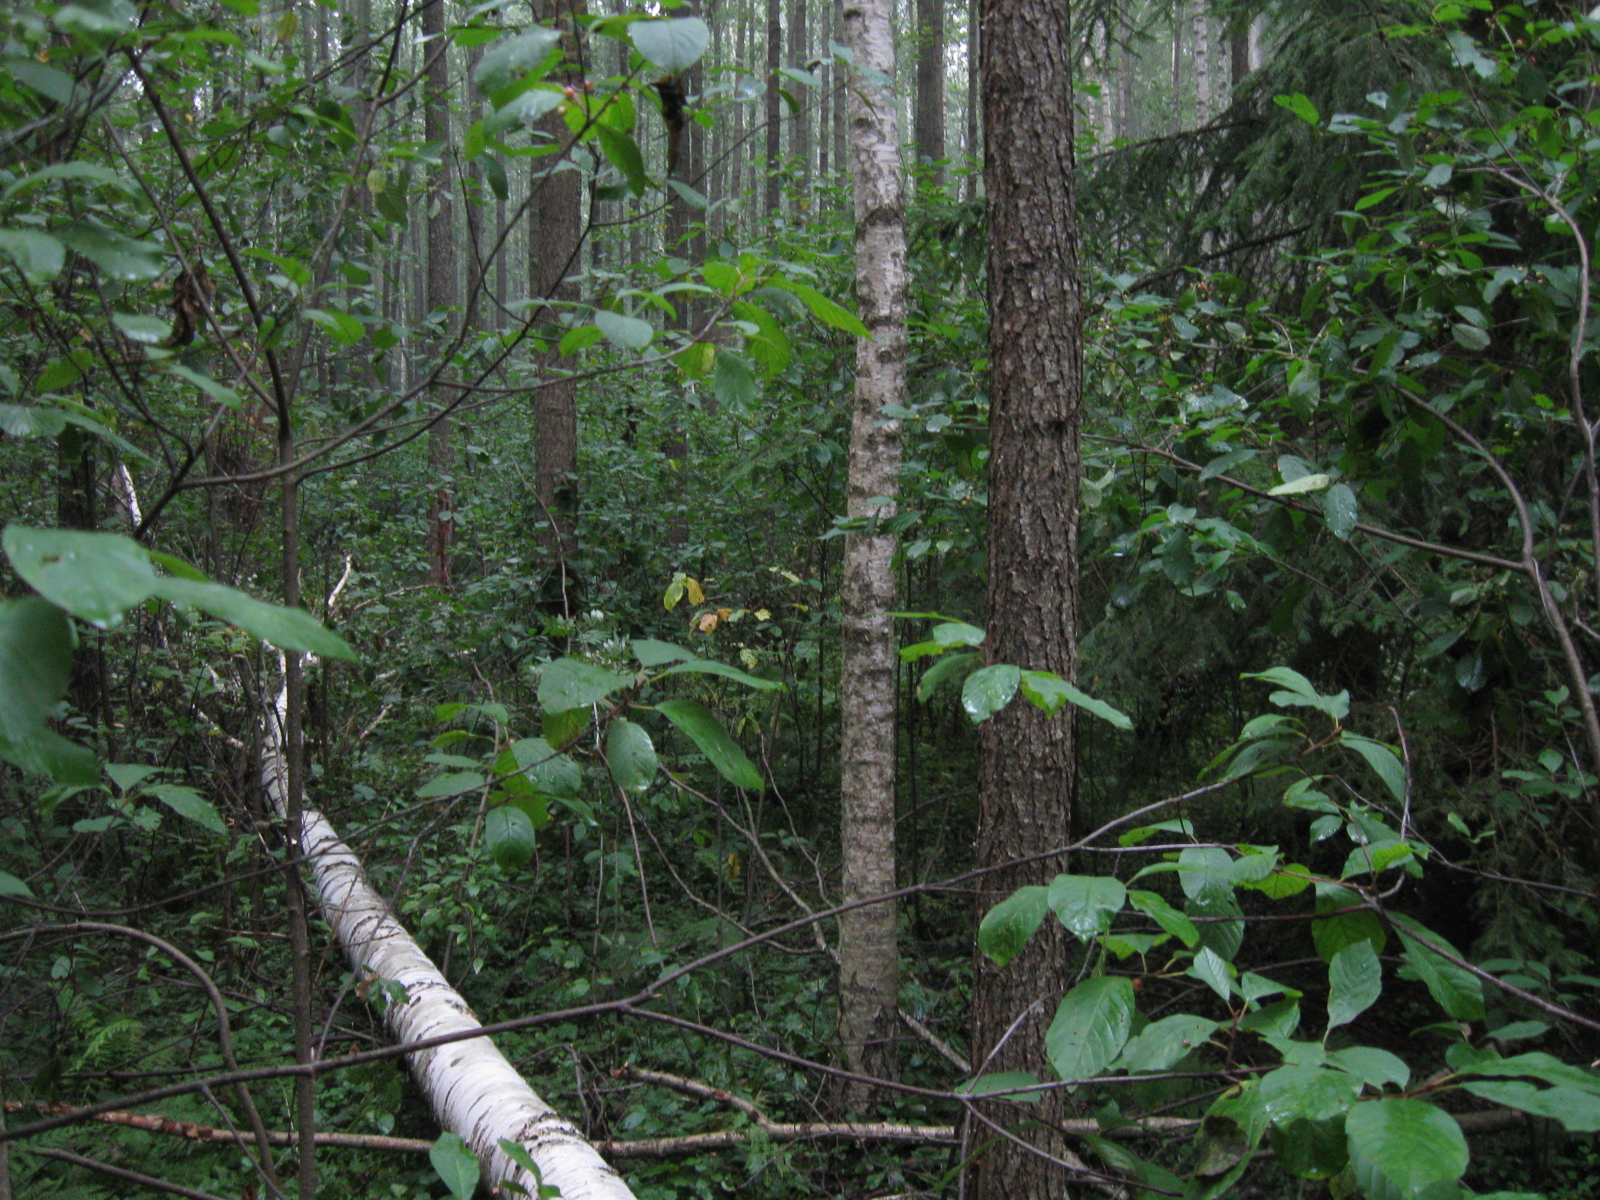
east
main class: Woodland
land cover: Broadleaved woodland
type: non-riverine alder, birch or aspen forest
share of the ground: > 75 %
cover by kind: broadleaved forest trees 85 %, coniferous forest trees 5 %, shrubs 5 %, herbaceous plants 5 %
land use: Forestry
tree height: > 5 m
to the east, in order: Broadleaved woodland; Other structural elements; Broadleaved woodland
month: August
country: LT
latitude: 54.7454
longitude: 23.6143
